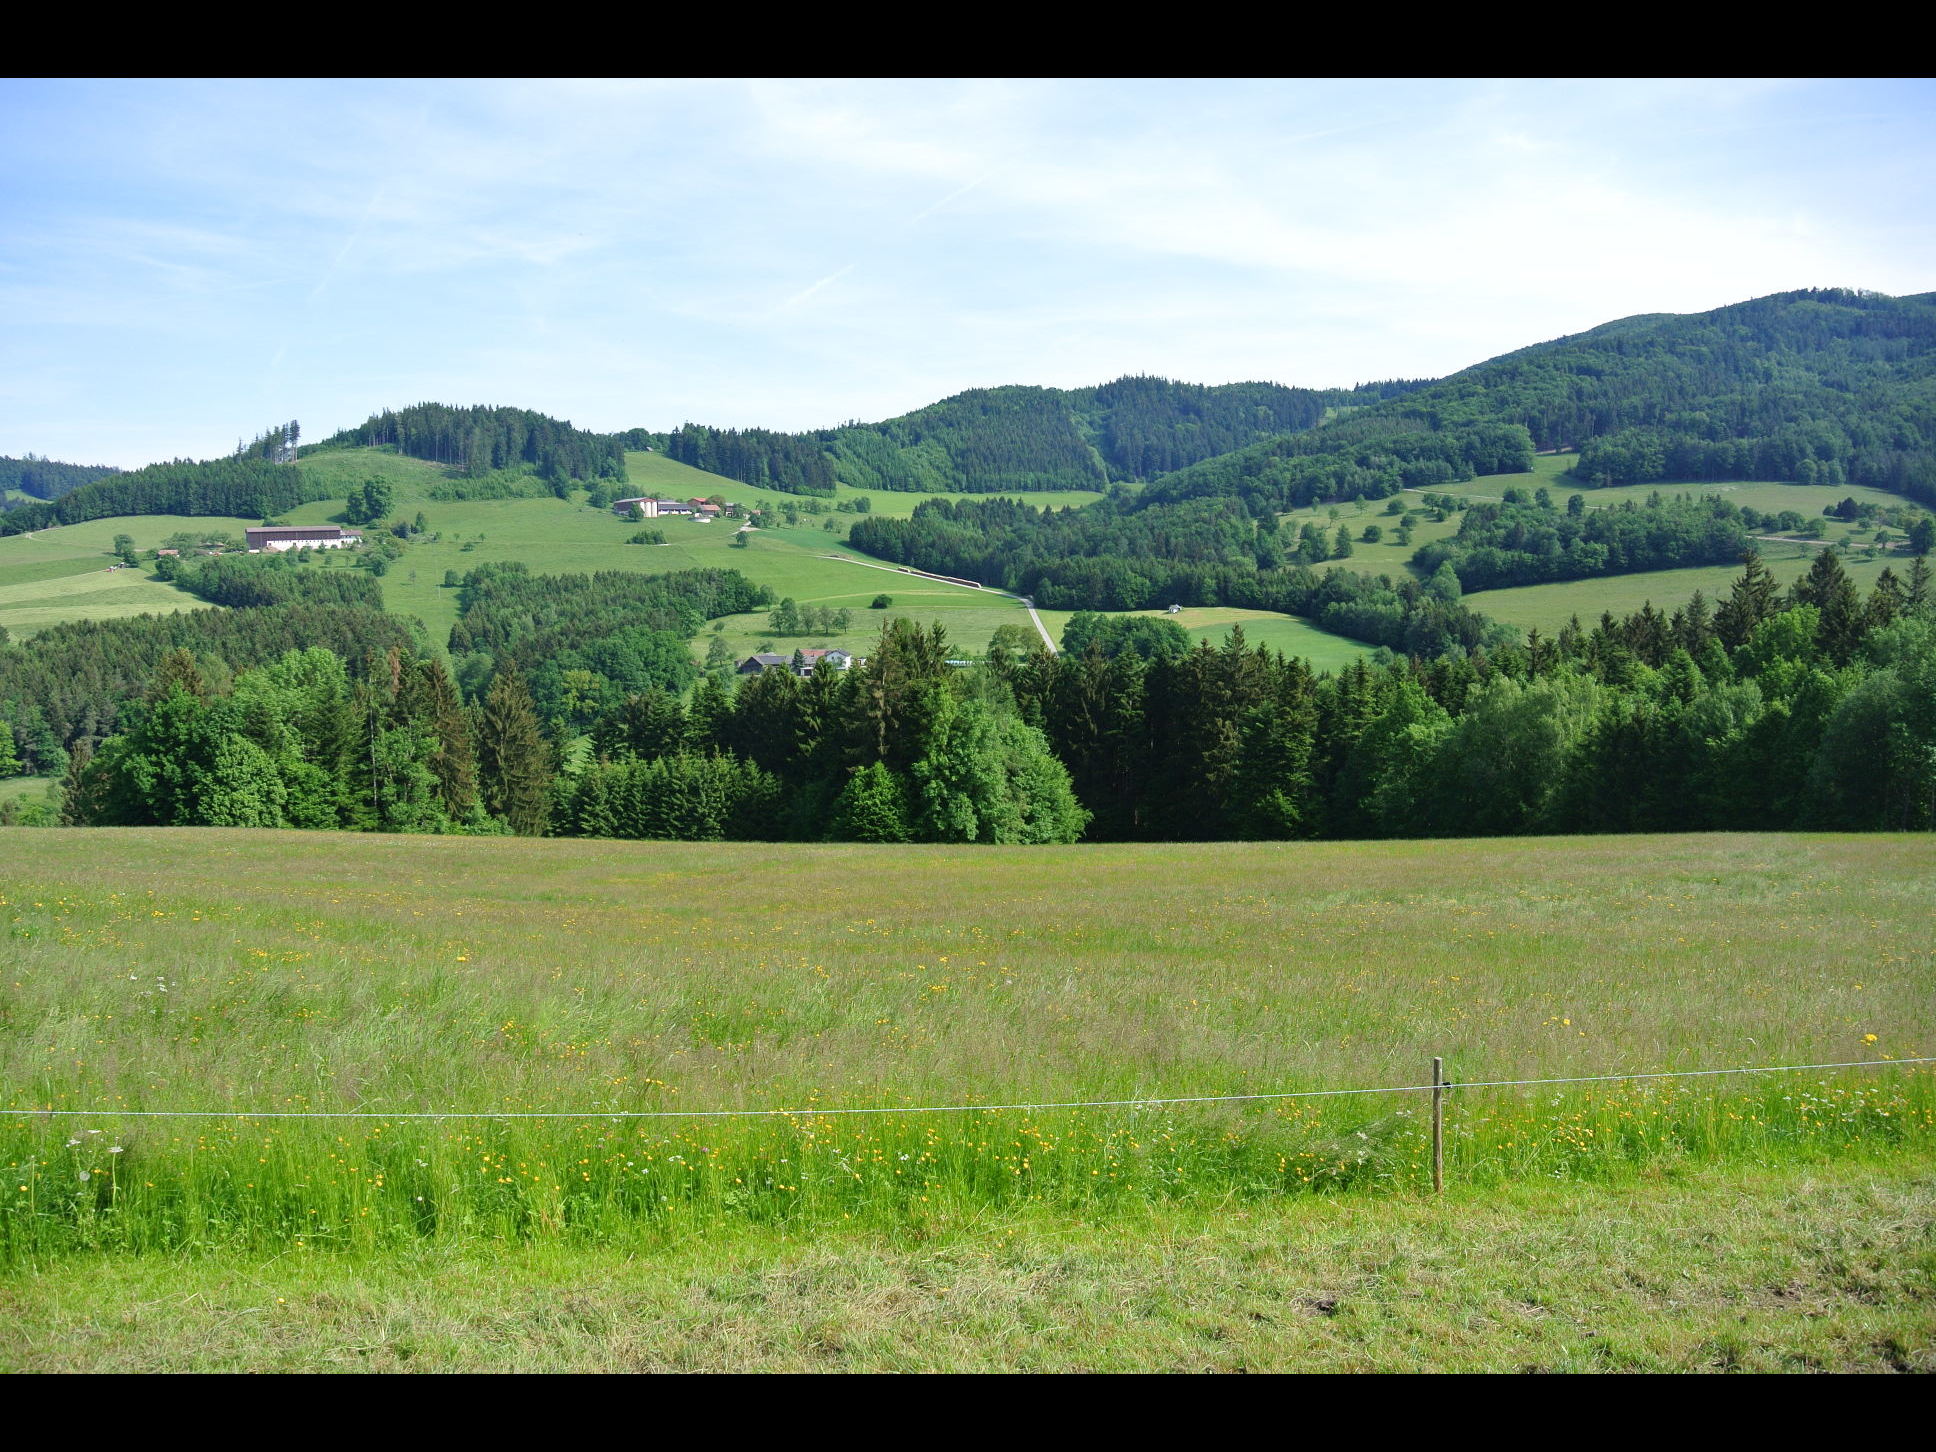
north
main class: Grassland
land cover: Grassland without tree/shrub cover
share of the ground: > 75 %
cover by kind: herbaceous plants 100 %
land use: Agriculture (excluding fallow land and kitchen gardens)
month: May
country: AT
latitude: 48.0522
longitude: 15.8120
